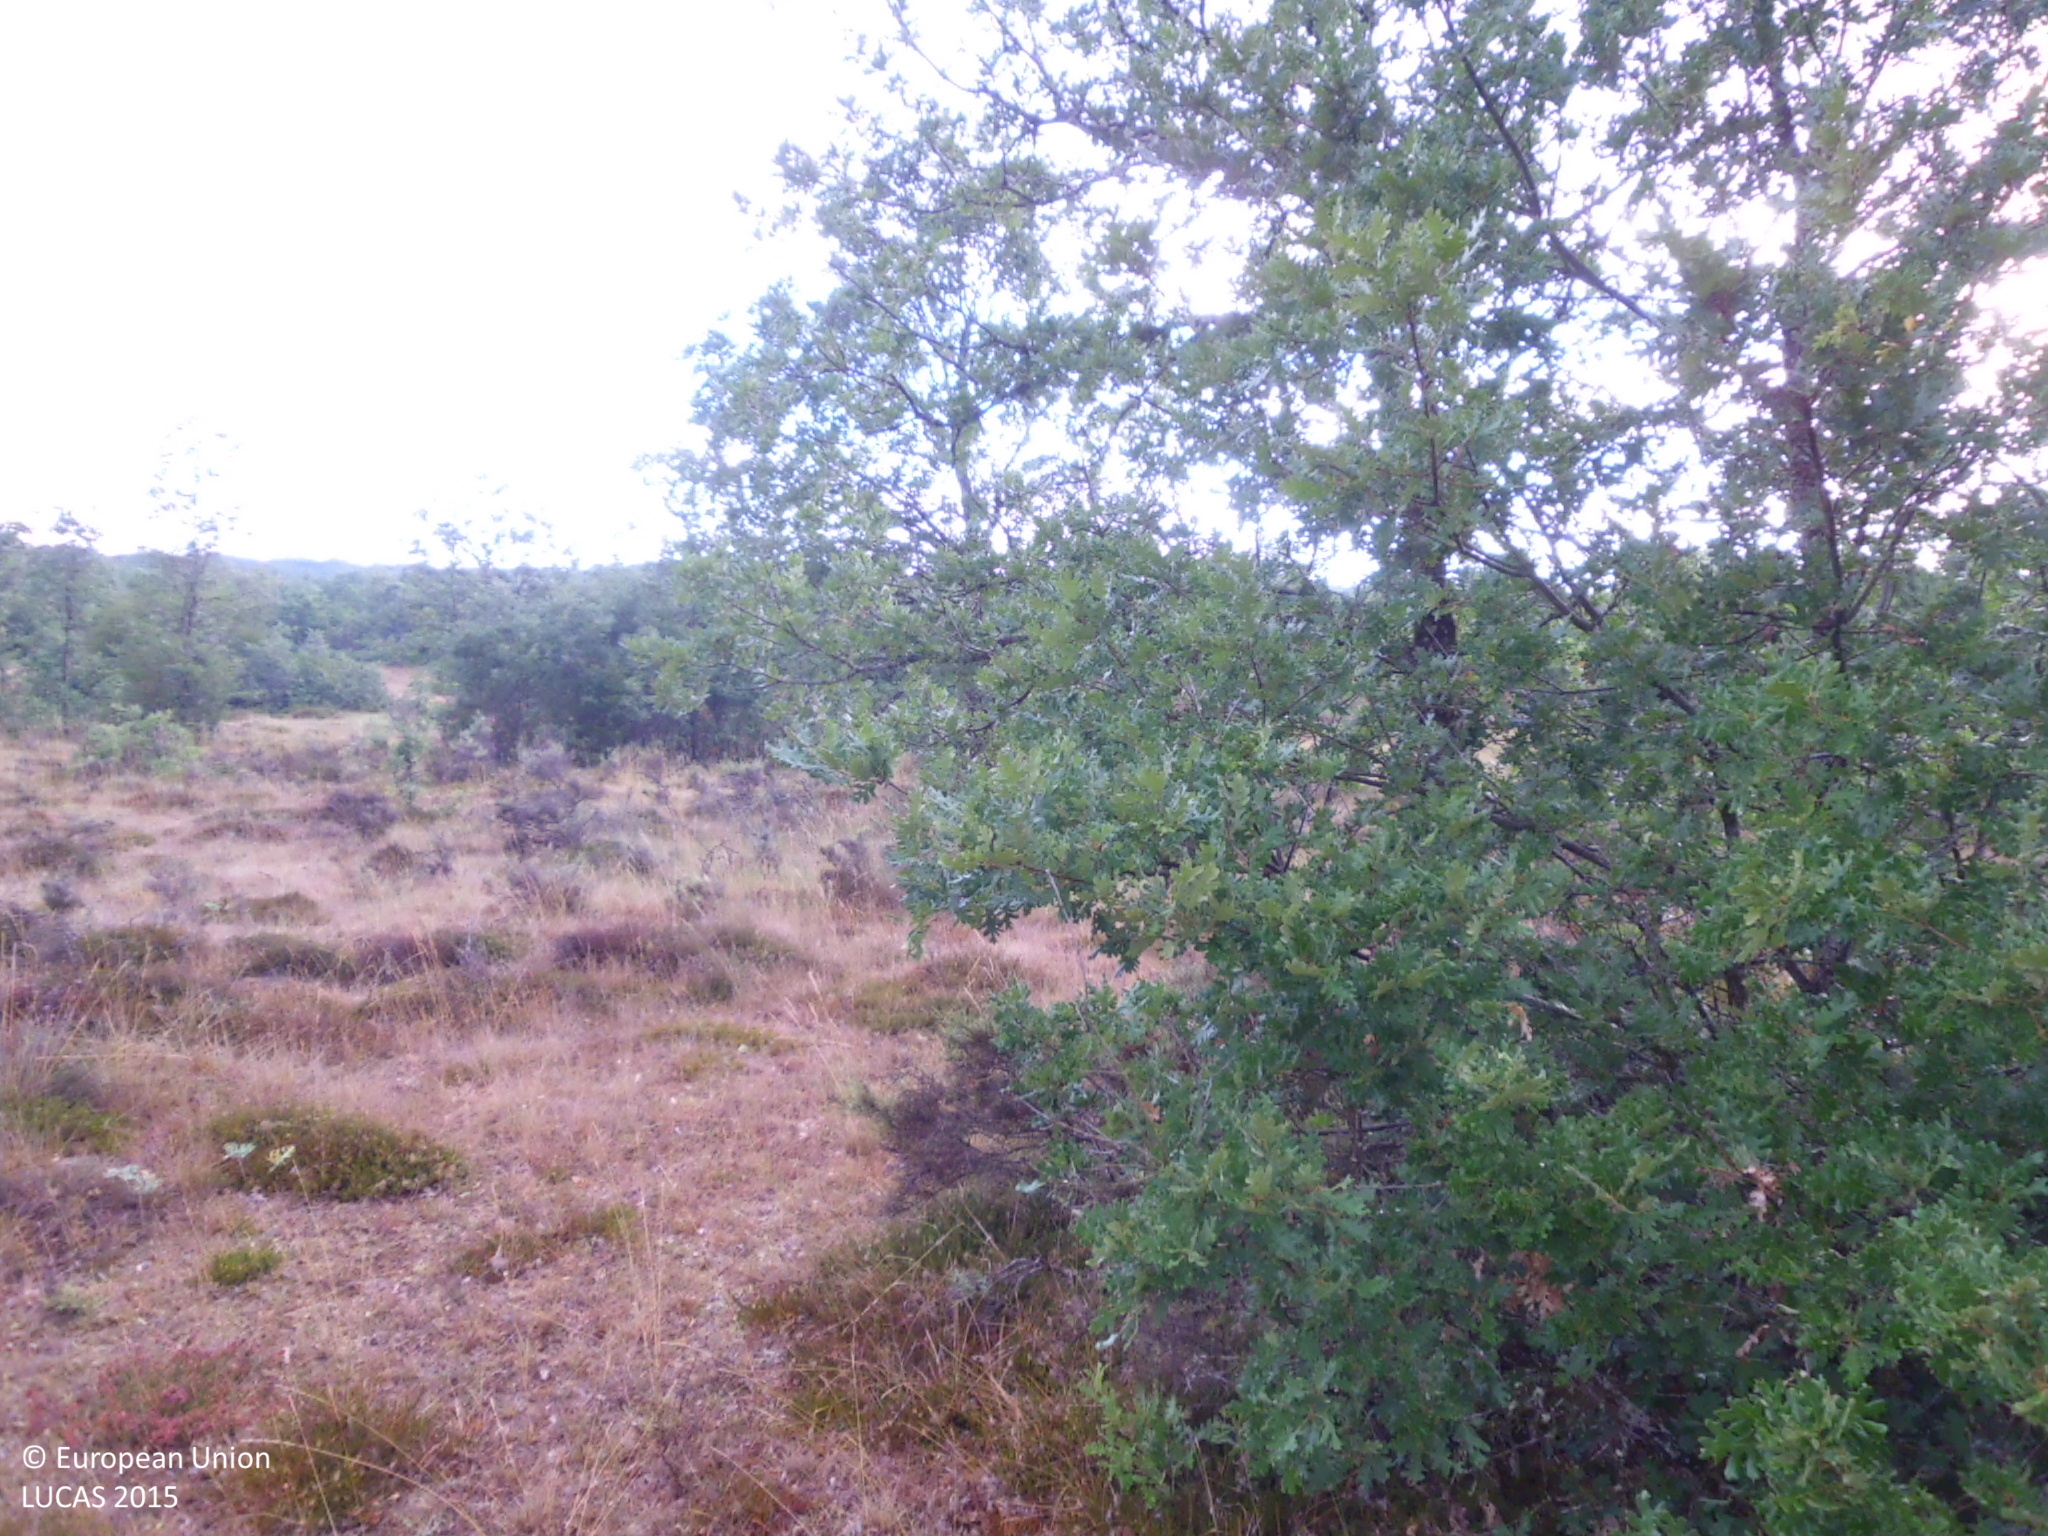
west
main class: Woodland
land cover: Broadleaved woodland
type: acidophilous oak and oak-birch forest
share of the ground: 25 - 50 %
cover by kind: herbaceous plants 50 %, broadleaved forest trees 25 %, shrubs 25 %
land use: Semi-natural and natural areas not in use
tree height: > 5 m
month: July
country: ES
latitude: 42.6612
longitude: -4.4106
